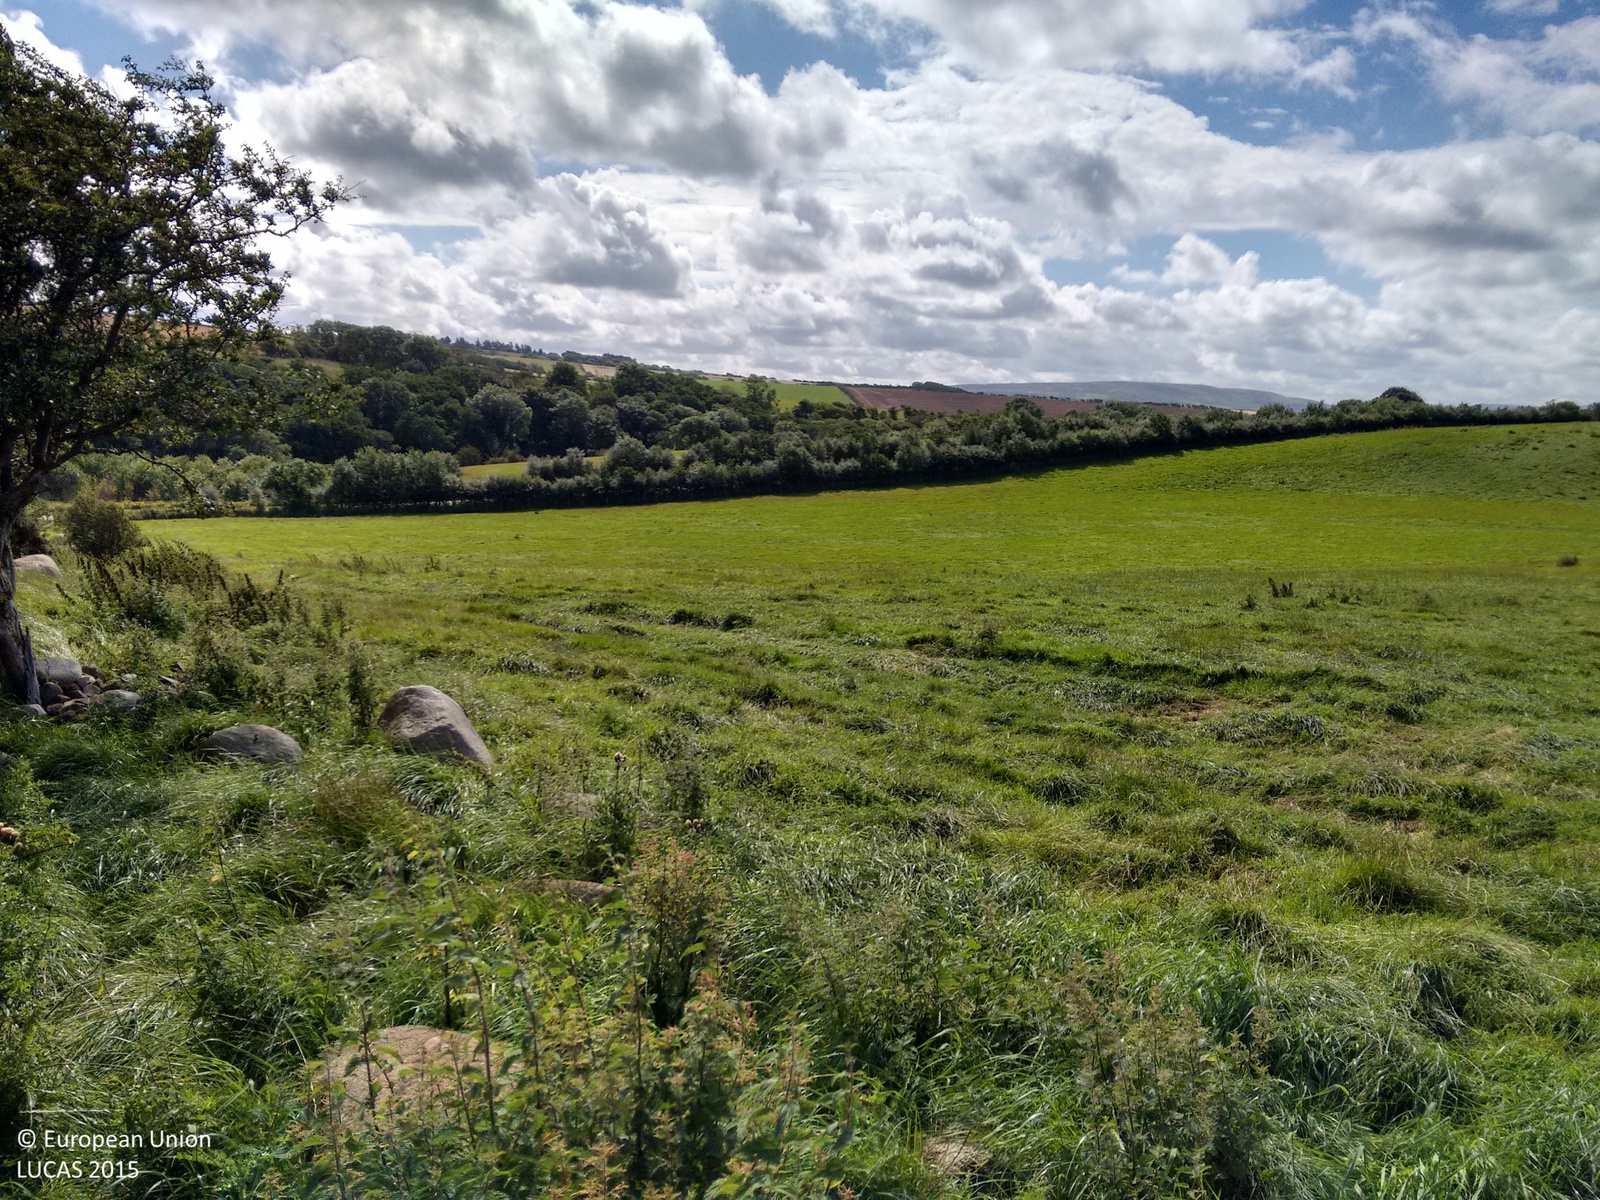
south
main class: Grassland
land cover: Grassland without tree/shrub cover
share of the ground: > 75 %
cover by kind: herbaceous plants 100 %
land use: Agriculture (excluding fallow land and kitchen gardens)
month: August
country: GB
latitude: 55.3213
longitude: -4.8114
